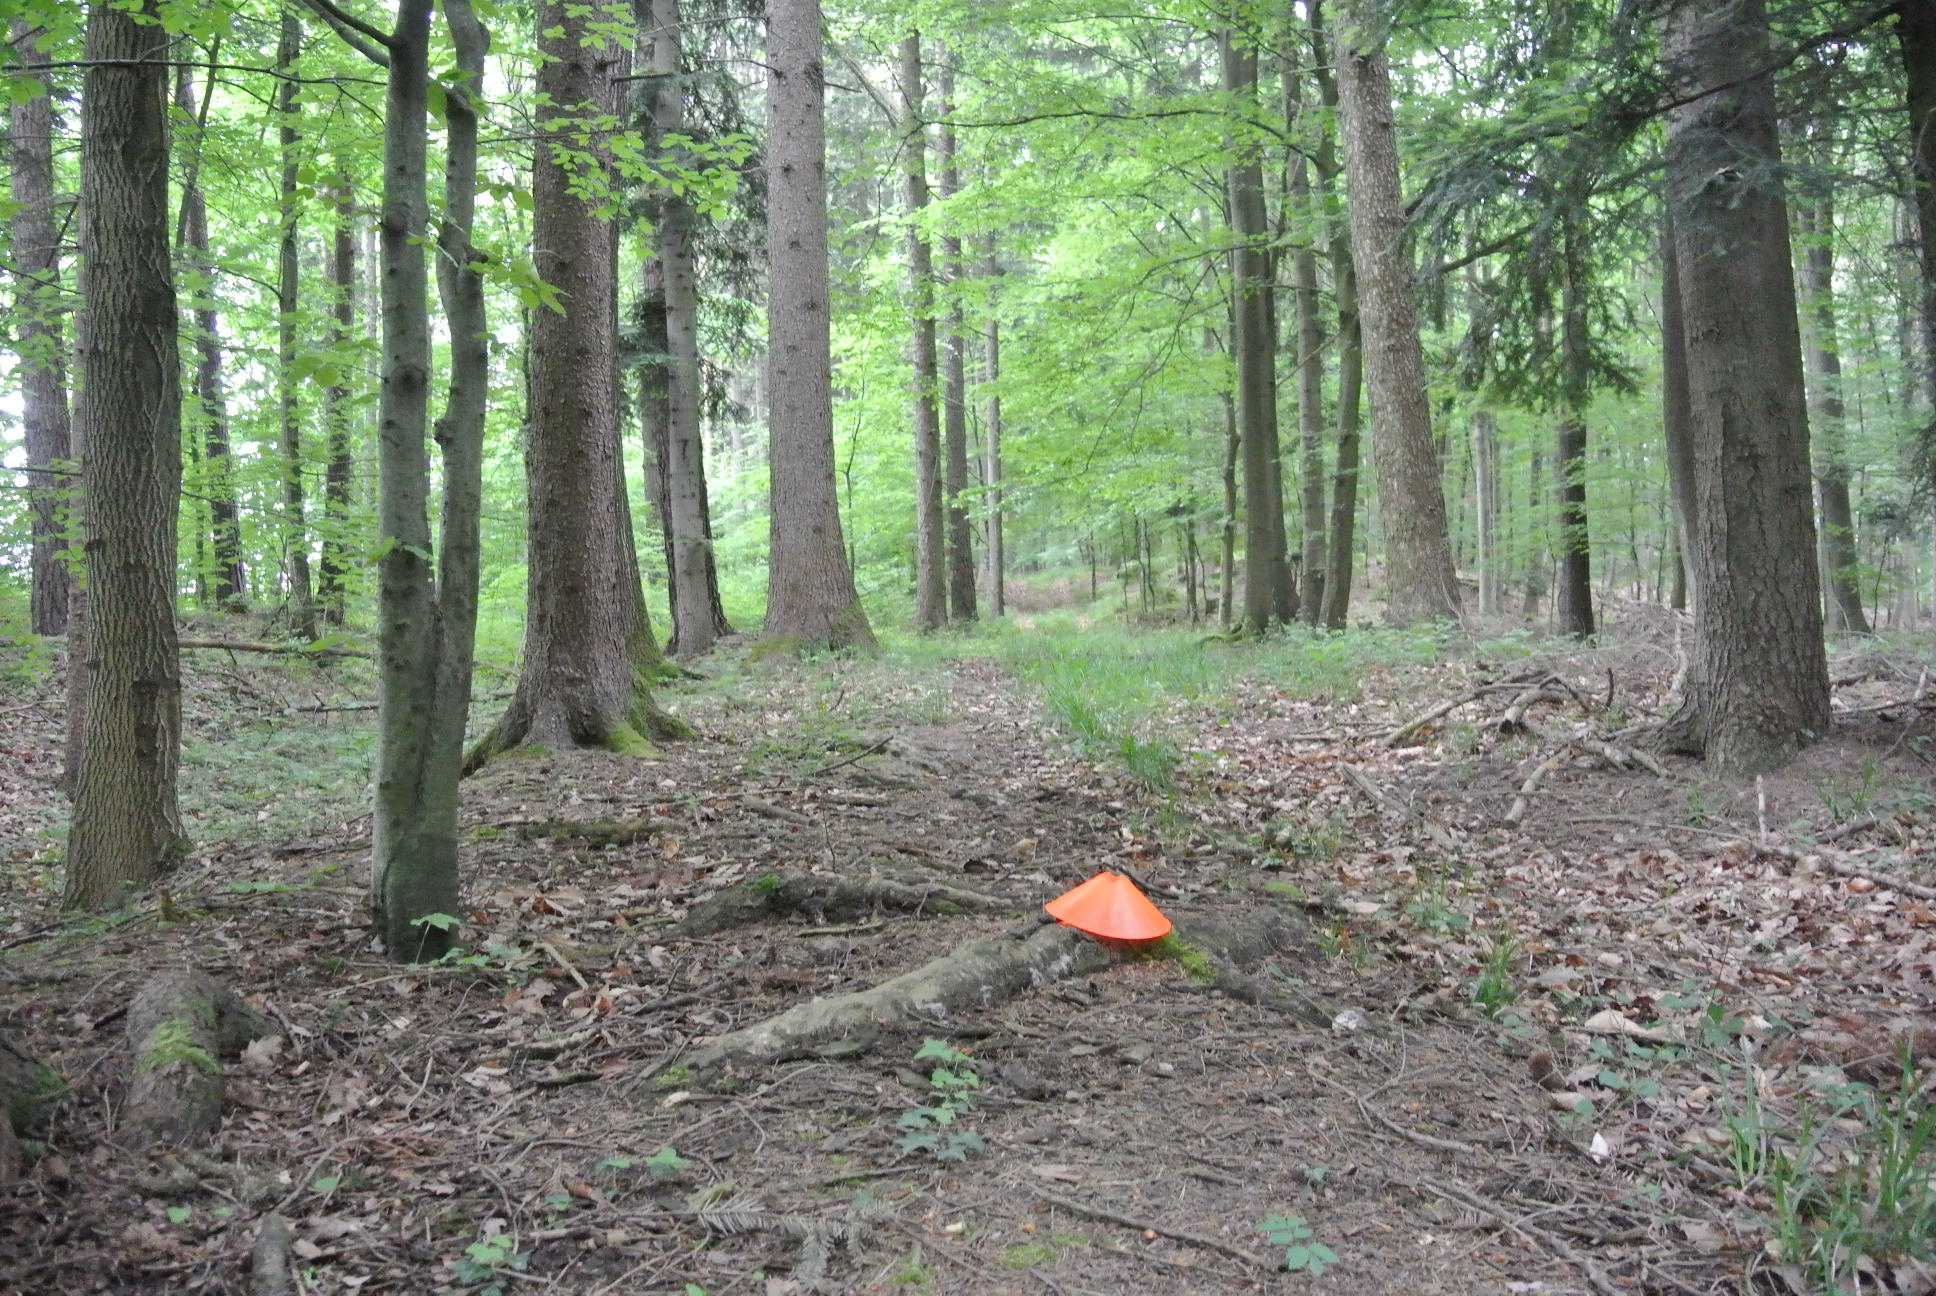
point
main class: Woodland
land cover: Other mixed woodland
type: mountainous beech forest
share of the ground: > 75 %
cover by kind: coniferous forest trees 60 %, broadleaved forest trees 40 %
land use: Forestry
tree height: > 5 m
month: May
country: AT
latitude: 48.1584
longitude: 15.8512
